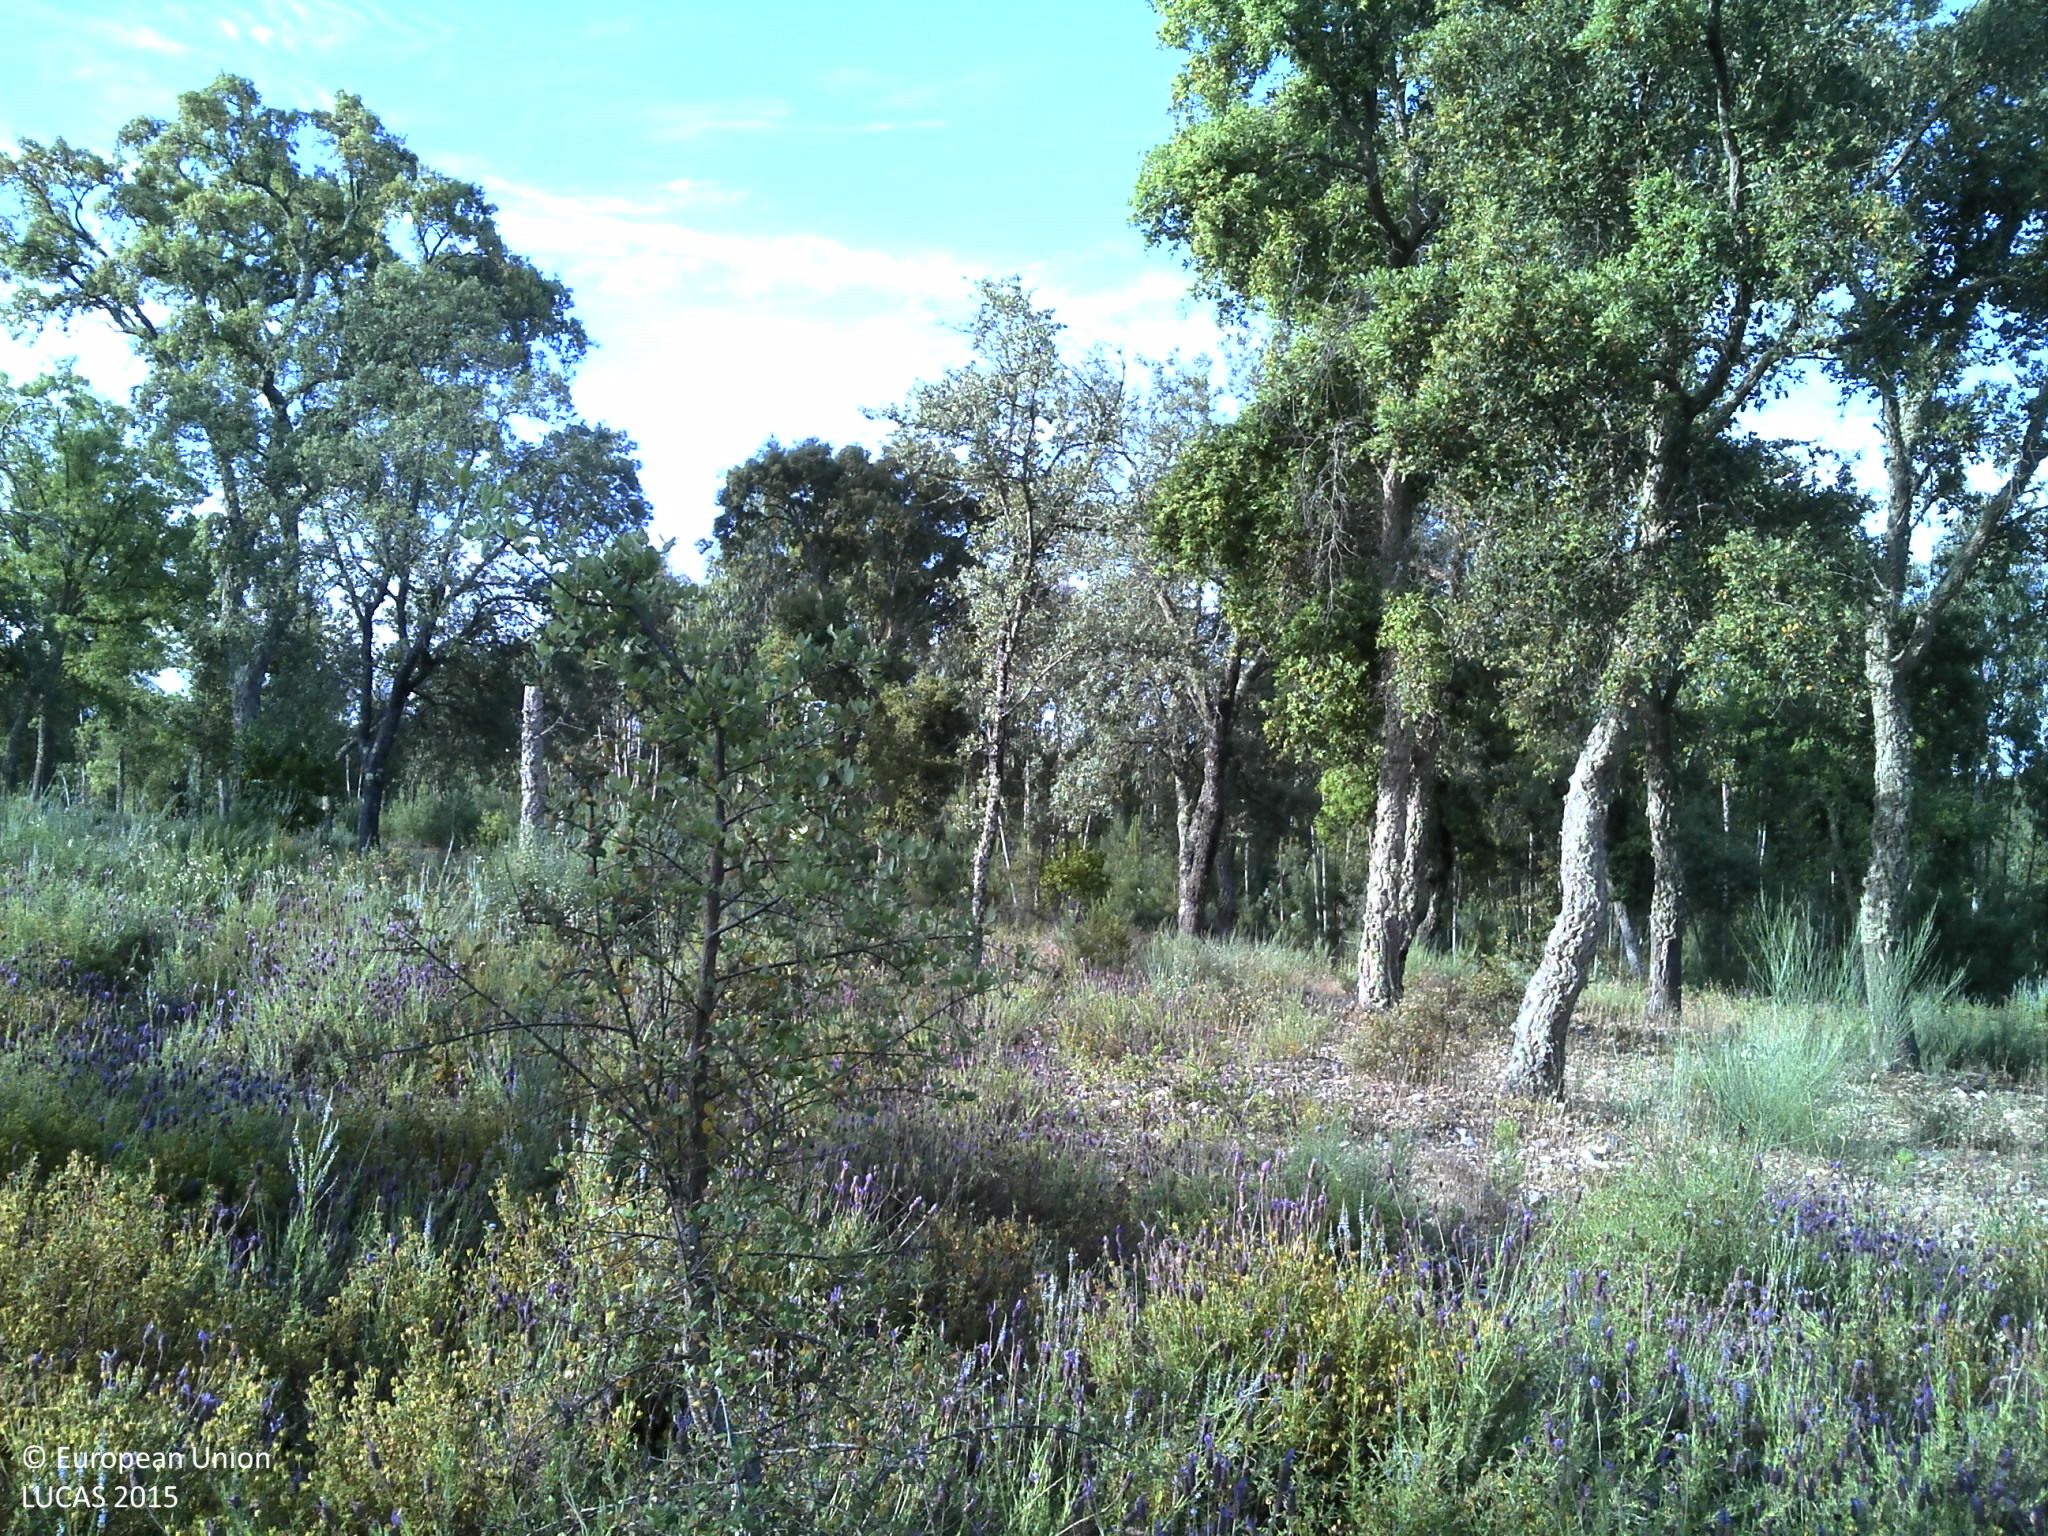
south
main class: Woodland
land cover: Broadleaved woodland
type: broadleaved evergreen forest
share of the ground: 25 - 50 %
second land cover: Shrubland without tree cover
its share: 50 - 75 %
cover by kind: broadleaved forest trees 30 %, shrubs 30 %, herbaceous plants 20 %, unconsolidated bare surface 20 %
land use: Forestry
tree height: > 5 m
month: May
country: PT
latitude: 39.3303
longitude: -7.9788
